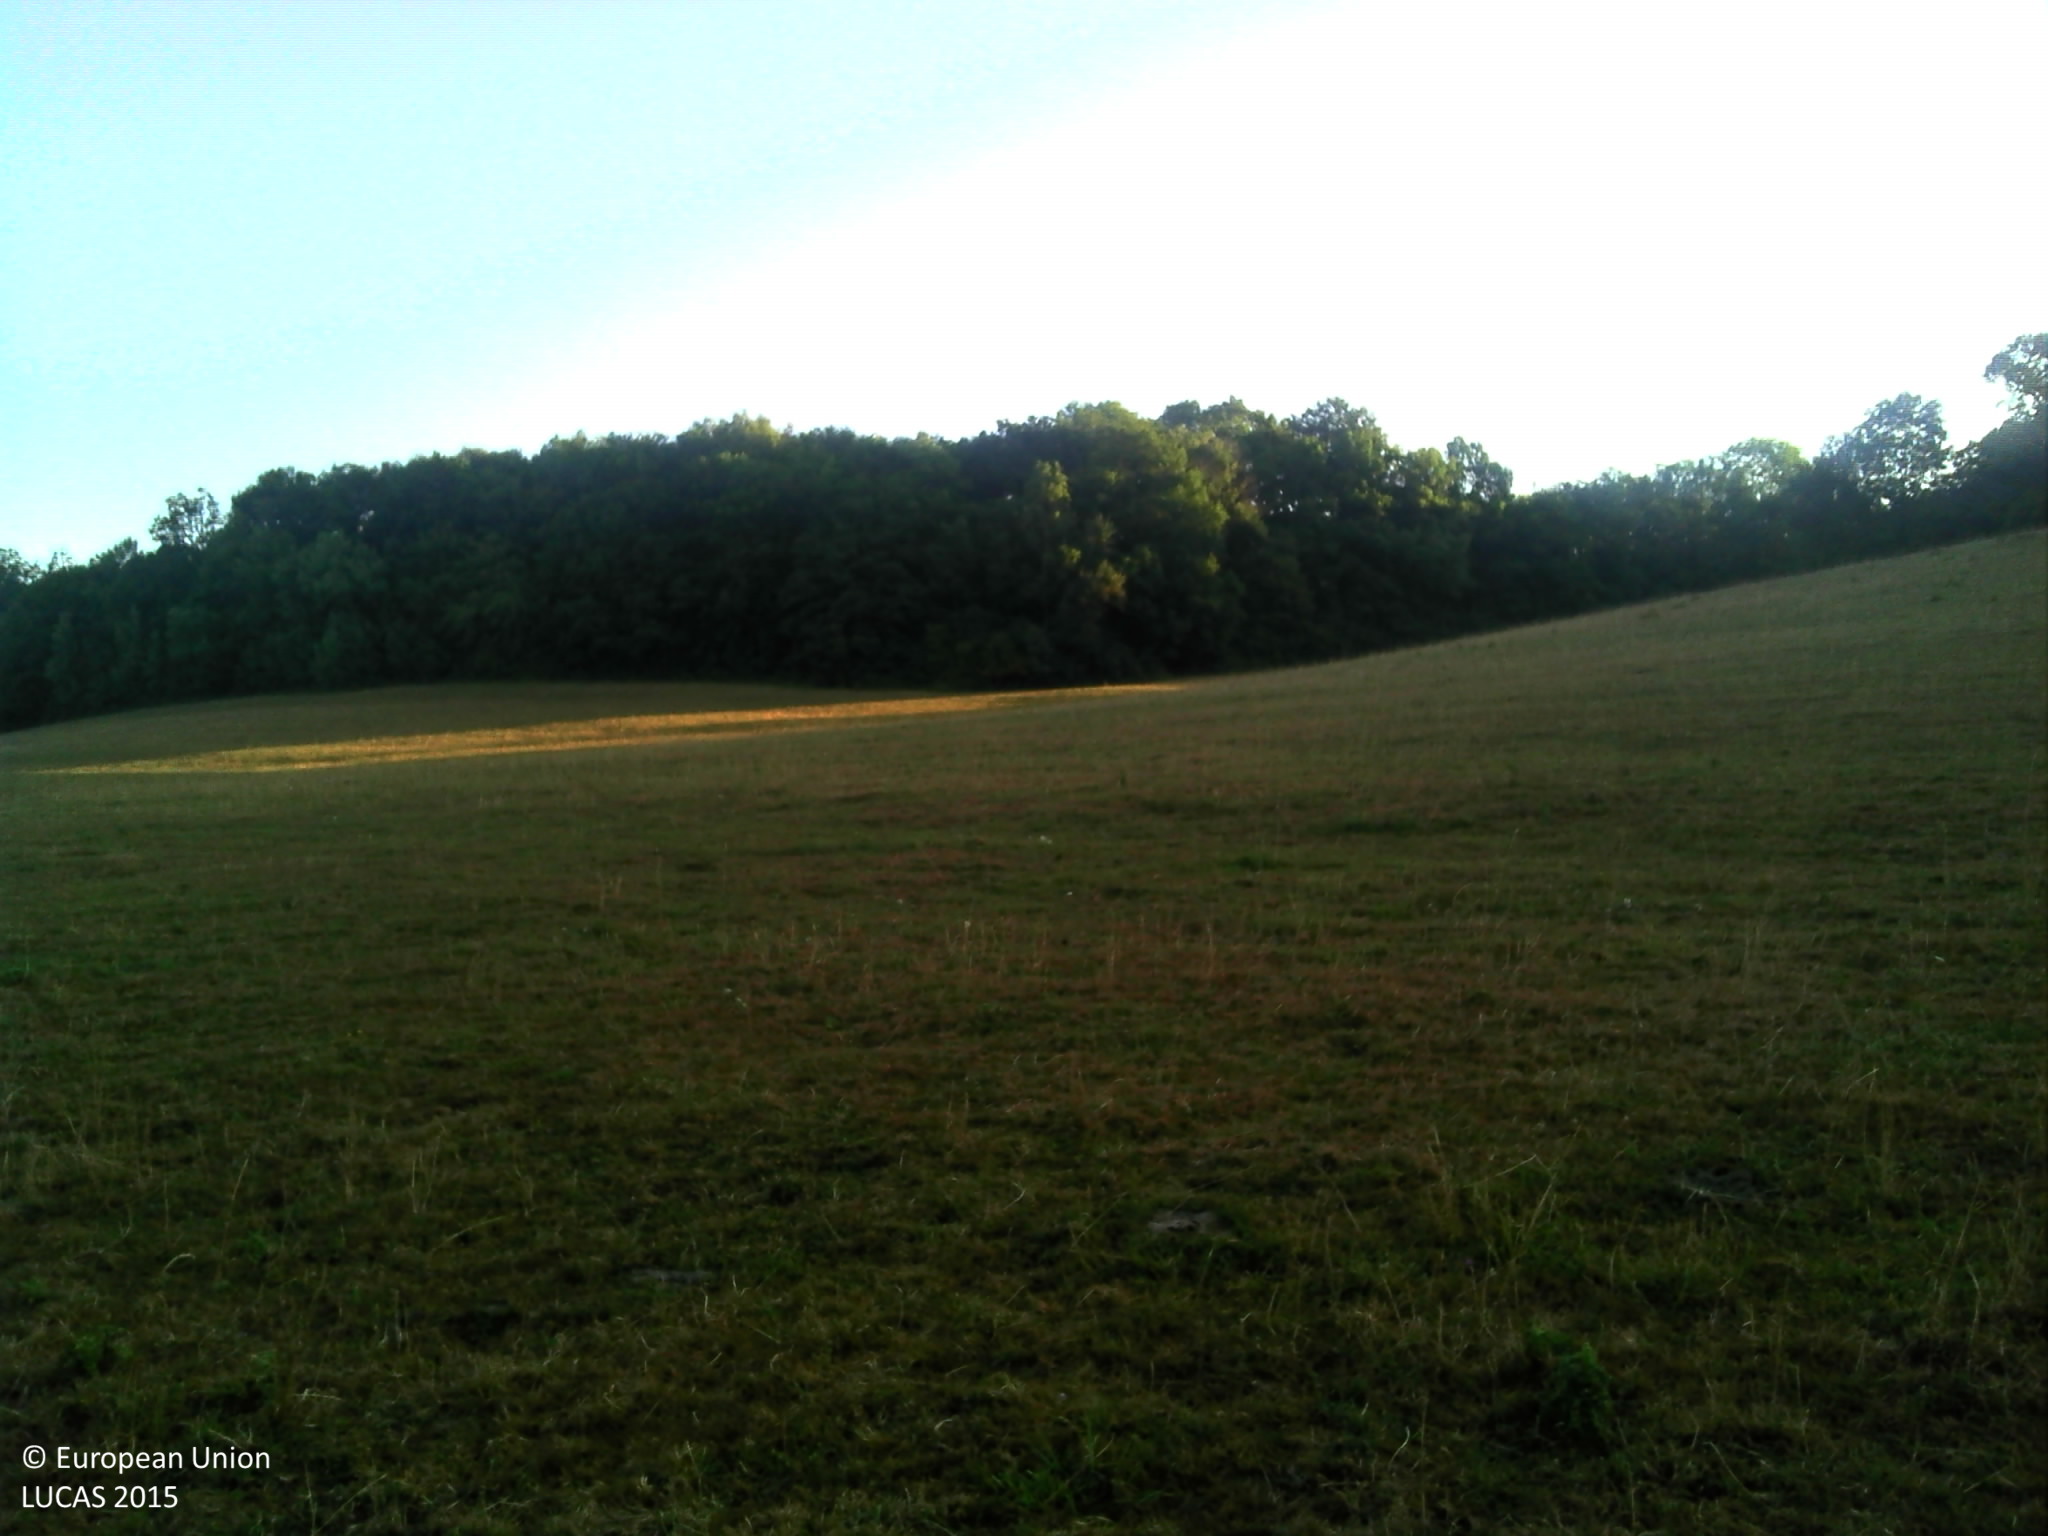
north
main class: Grassland
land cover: Grassland without tree/shrub cover
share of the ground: > 75 %
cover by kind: herbaceous plants 100 %
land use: Agriculture (excluding fallow land and kitchen gardens)
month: July
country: FR
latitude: 47.8747
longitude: 5.3873
